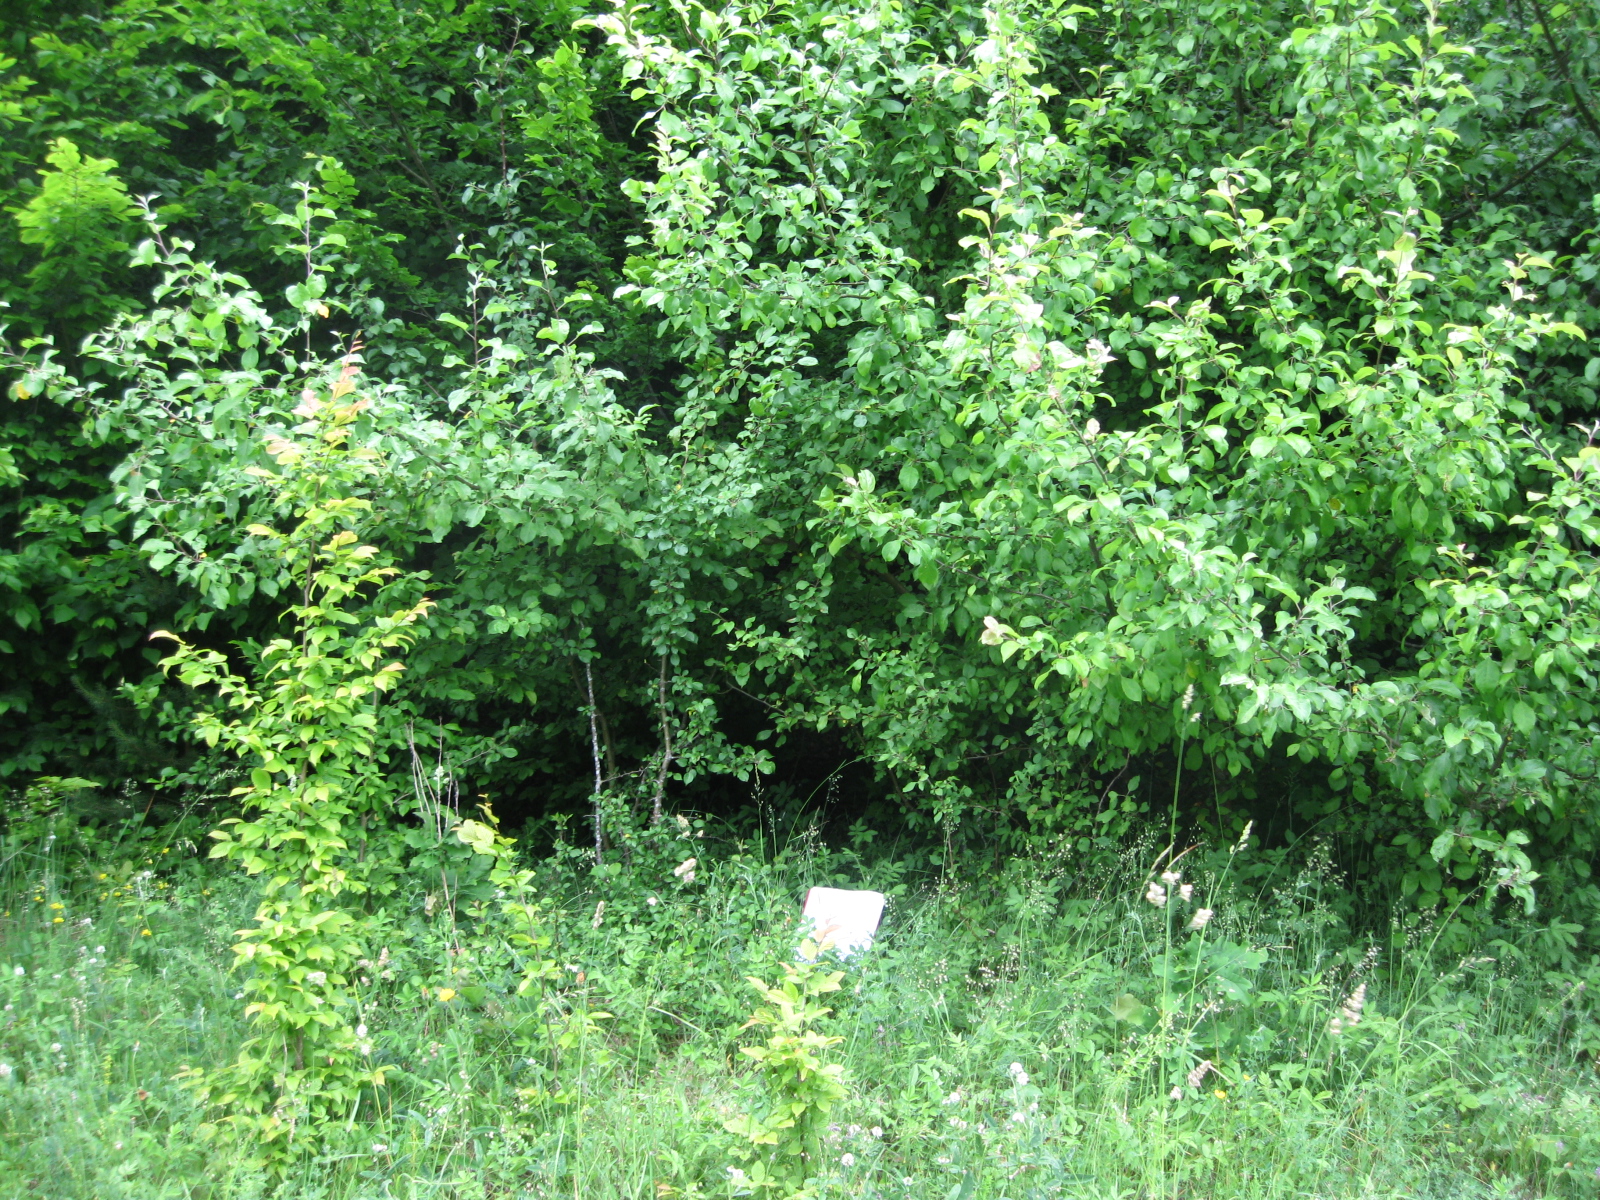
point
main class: Woodland
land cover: Broadleaved woodland
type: non-riverine alder, birch or aspen forest
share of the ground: > 75 %
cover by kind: broadleaved forest trees 85 %, herbaceous plants 10 %, lichens and mosses 5 %
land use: Semi-natural and natural areas not in use
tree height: > 5 m
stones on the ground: < 10 %
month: June
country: LT
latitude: 55.2510
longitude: 23.4988
